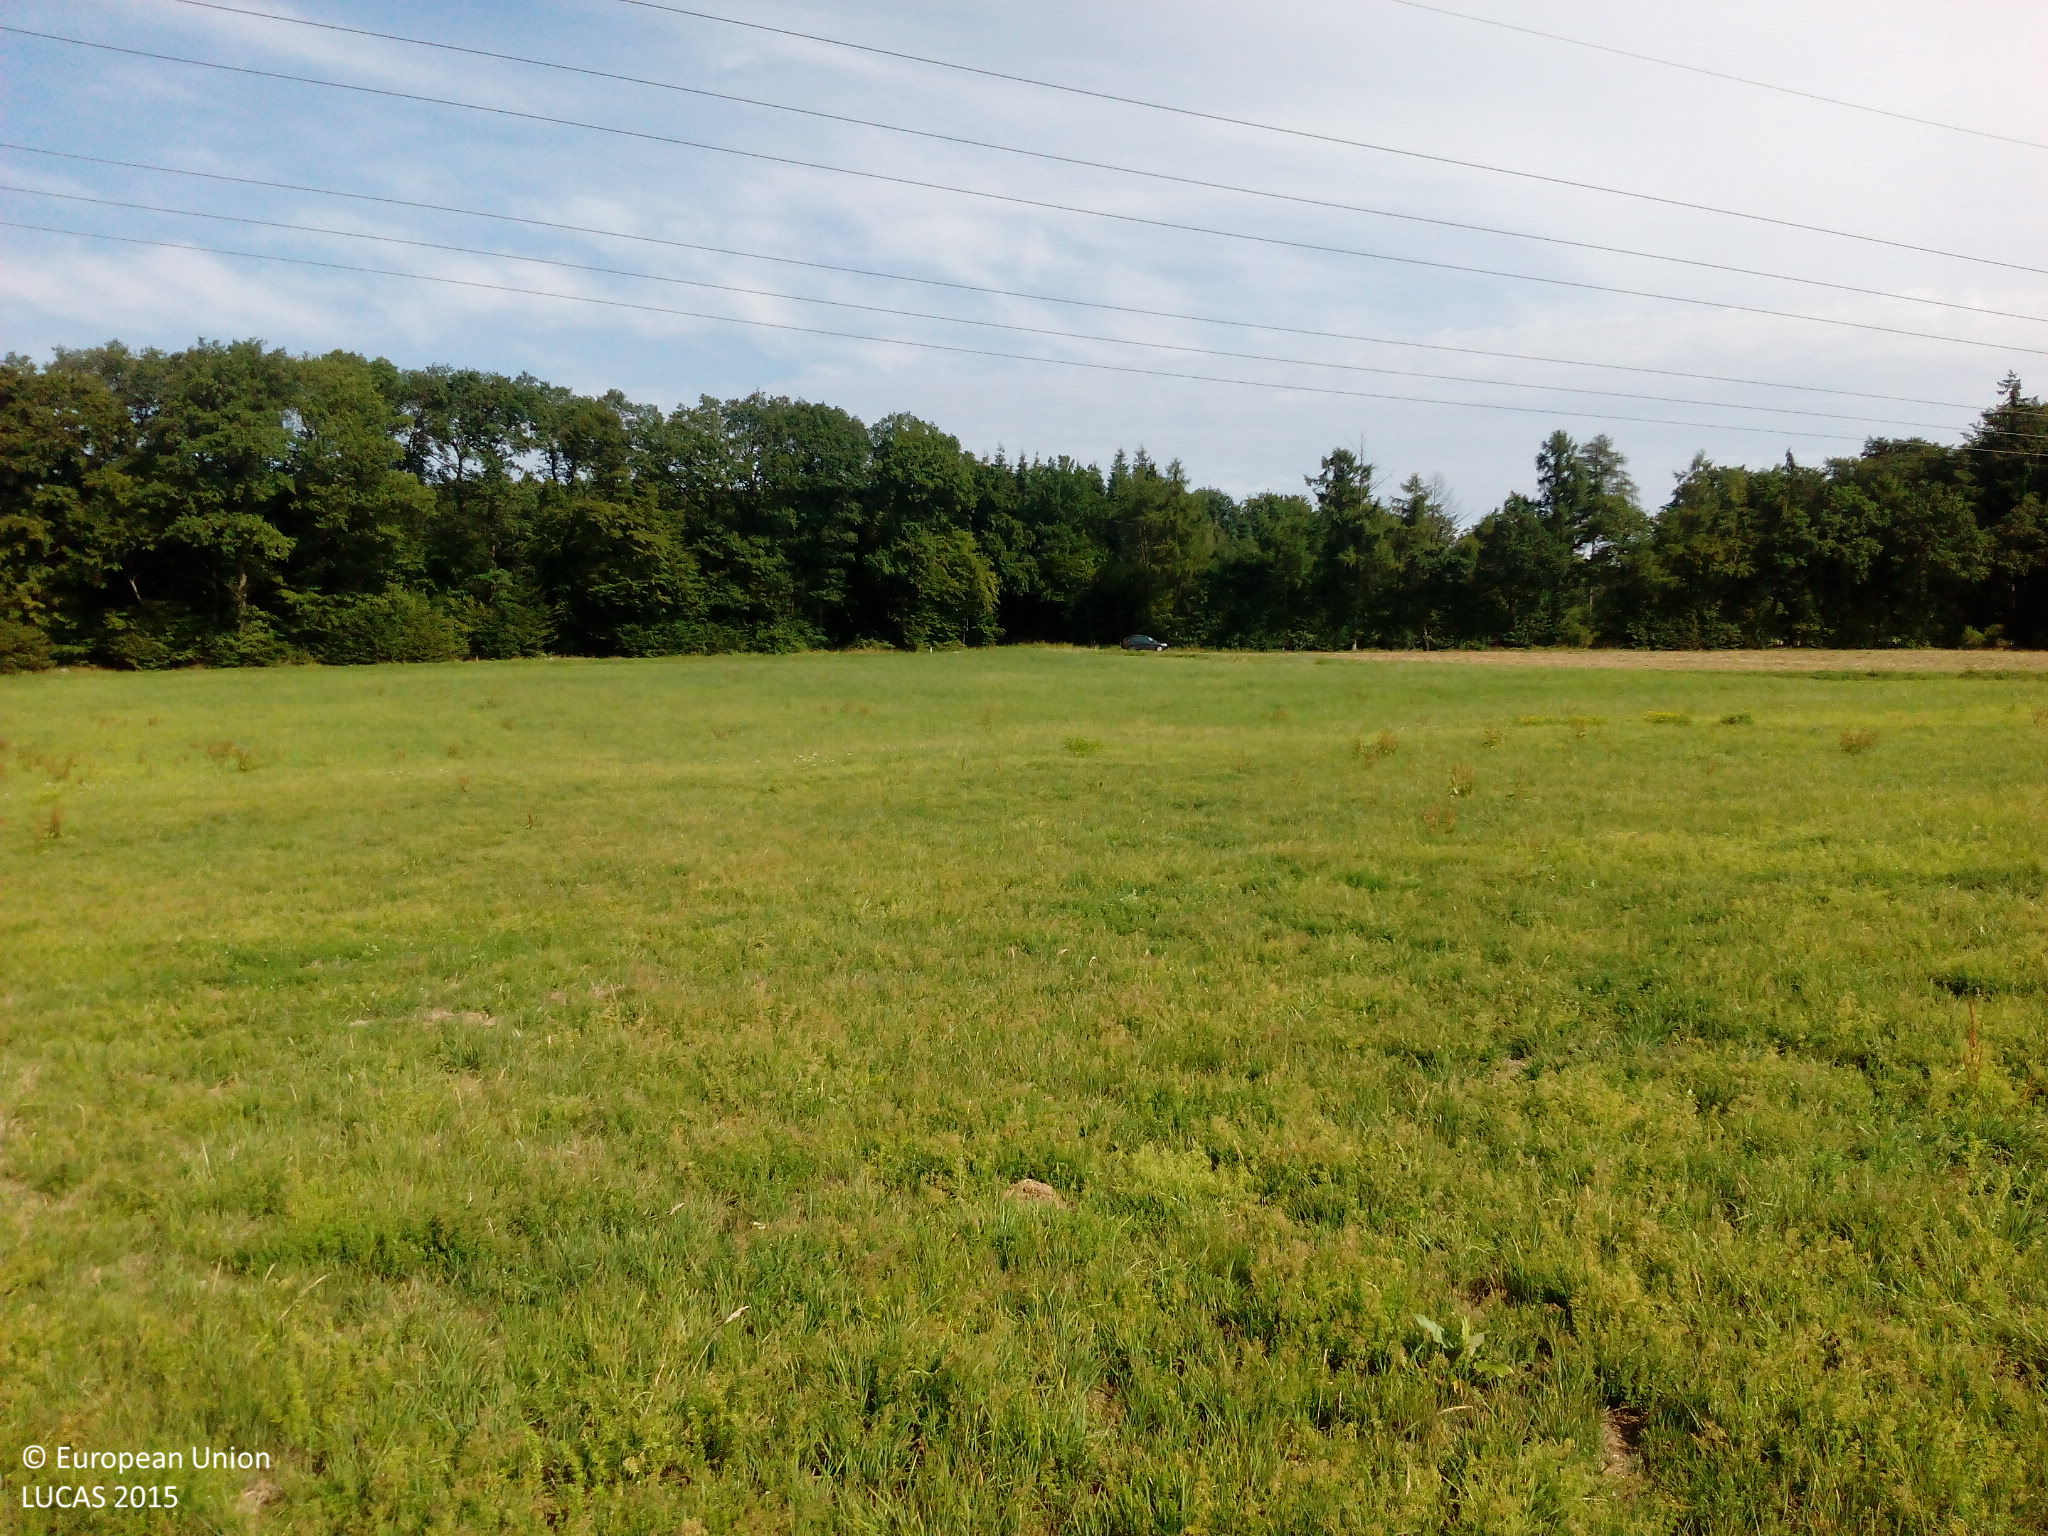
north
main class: Grassland
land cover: Grassland without tree/shrub cover
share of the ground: > 75 %
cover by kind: herbaceous plants 90 %, unconsolidated bare surface 10 %
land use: Agriculture (excluding fallow land and kitchen gardens)
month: August
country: DE
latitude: 50.2652
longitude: 7.5172
